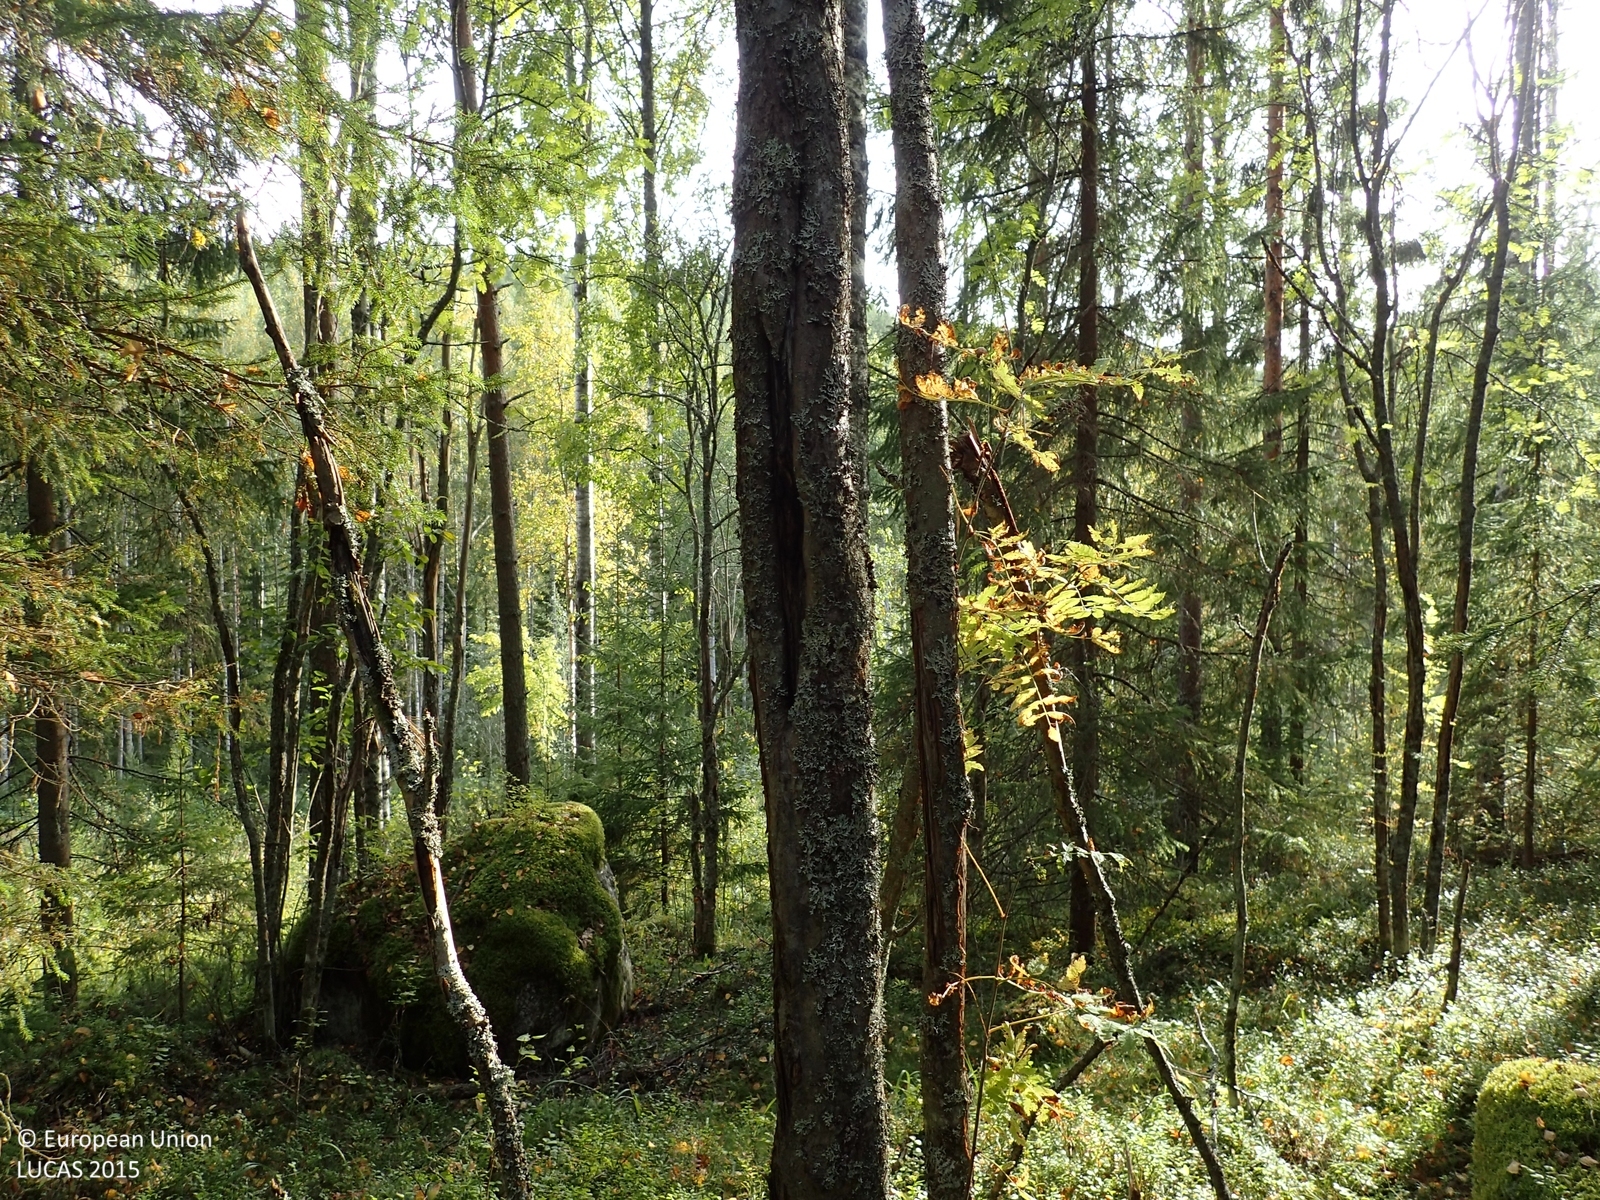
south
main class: Woodland
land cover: Pine dominated mixed woodland
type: boreal forest
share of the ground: > 75 %
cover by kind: coniferous forest trees 55 %, broadleaved forest trees 20 %, shrubs 20 %, herbaceous plants 5 %
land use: Forestry
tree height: > 5 m
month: September
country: FI
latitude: 63.0001
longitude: 26.2157
